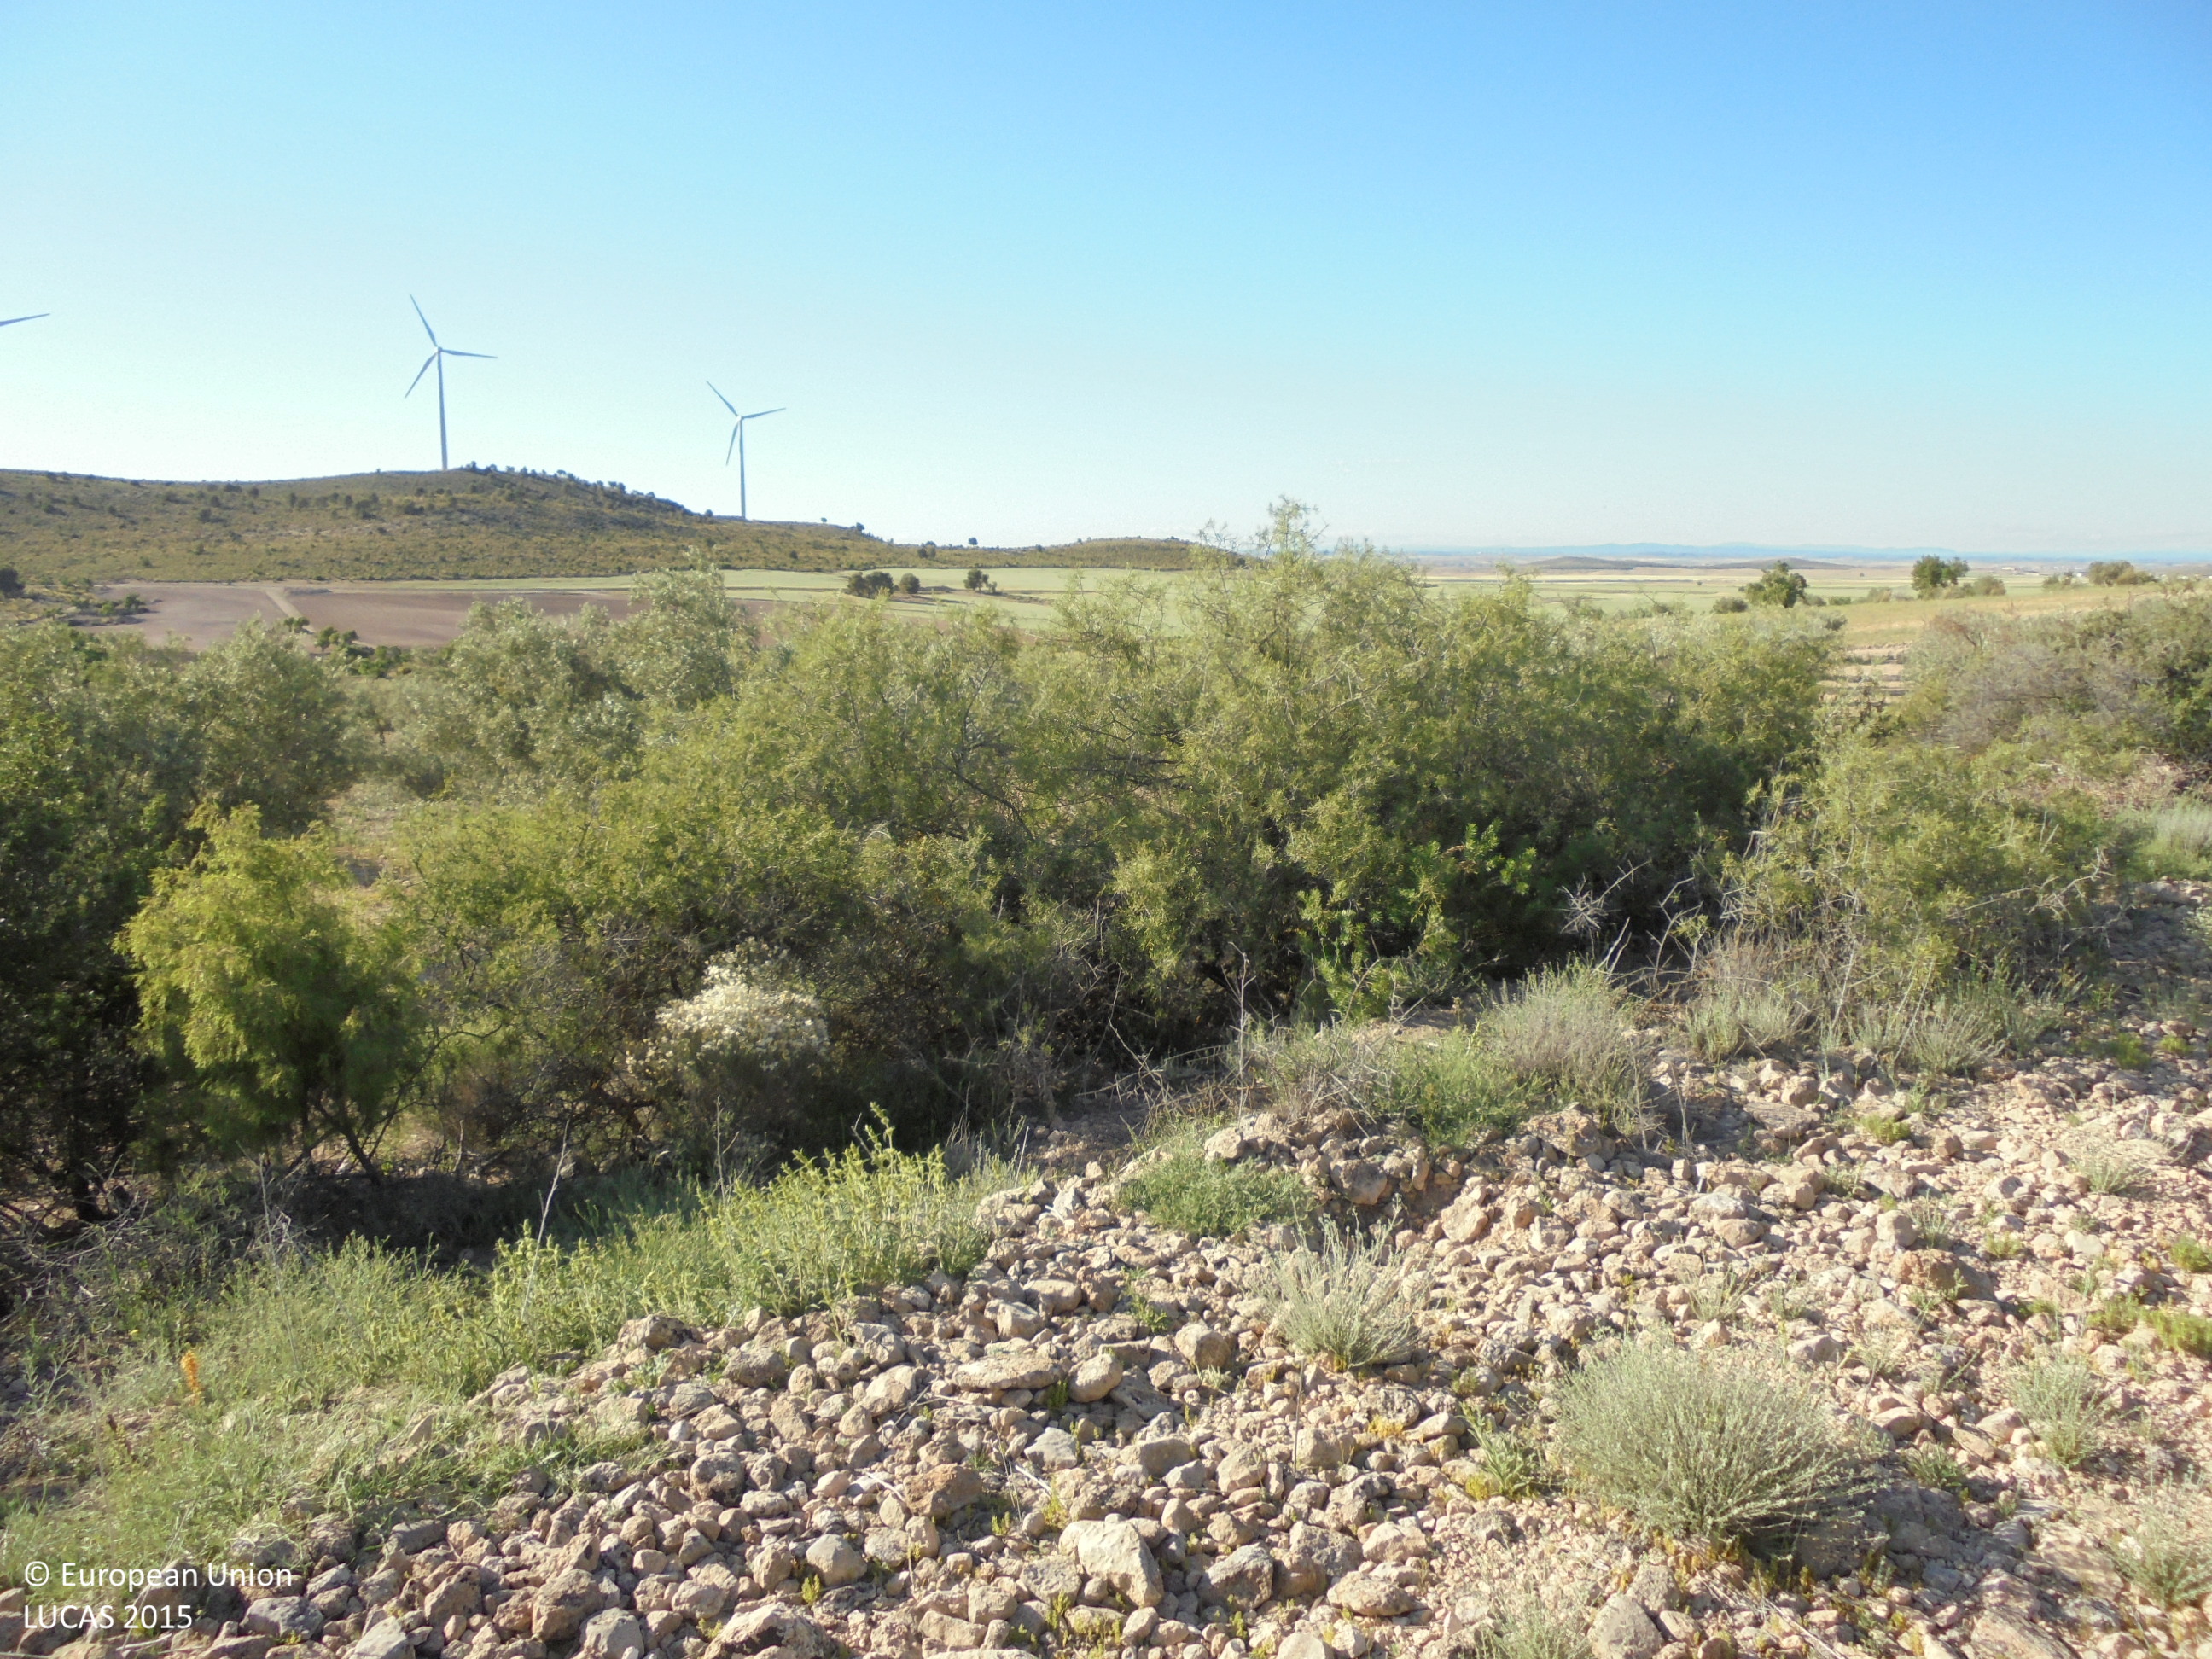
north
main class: Cropland
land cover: Olive groves
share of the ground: 10 - 25 %
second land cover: Spontaneously vegetated surfaces
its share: 50 - 75 %
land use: Agriculture (excluding fallow land and kitchen gardens)
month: May
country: ES
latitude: 39.0800
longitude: -1.4777
